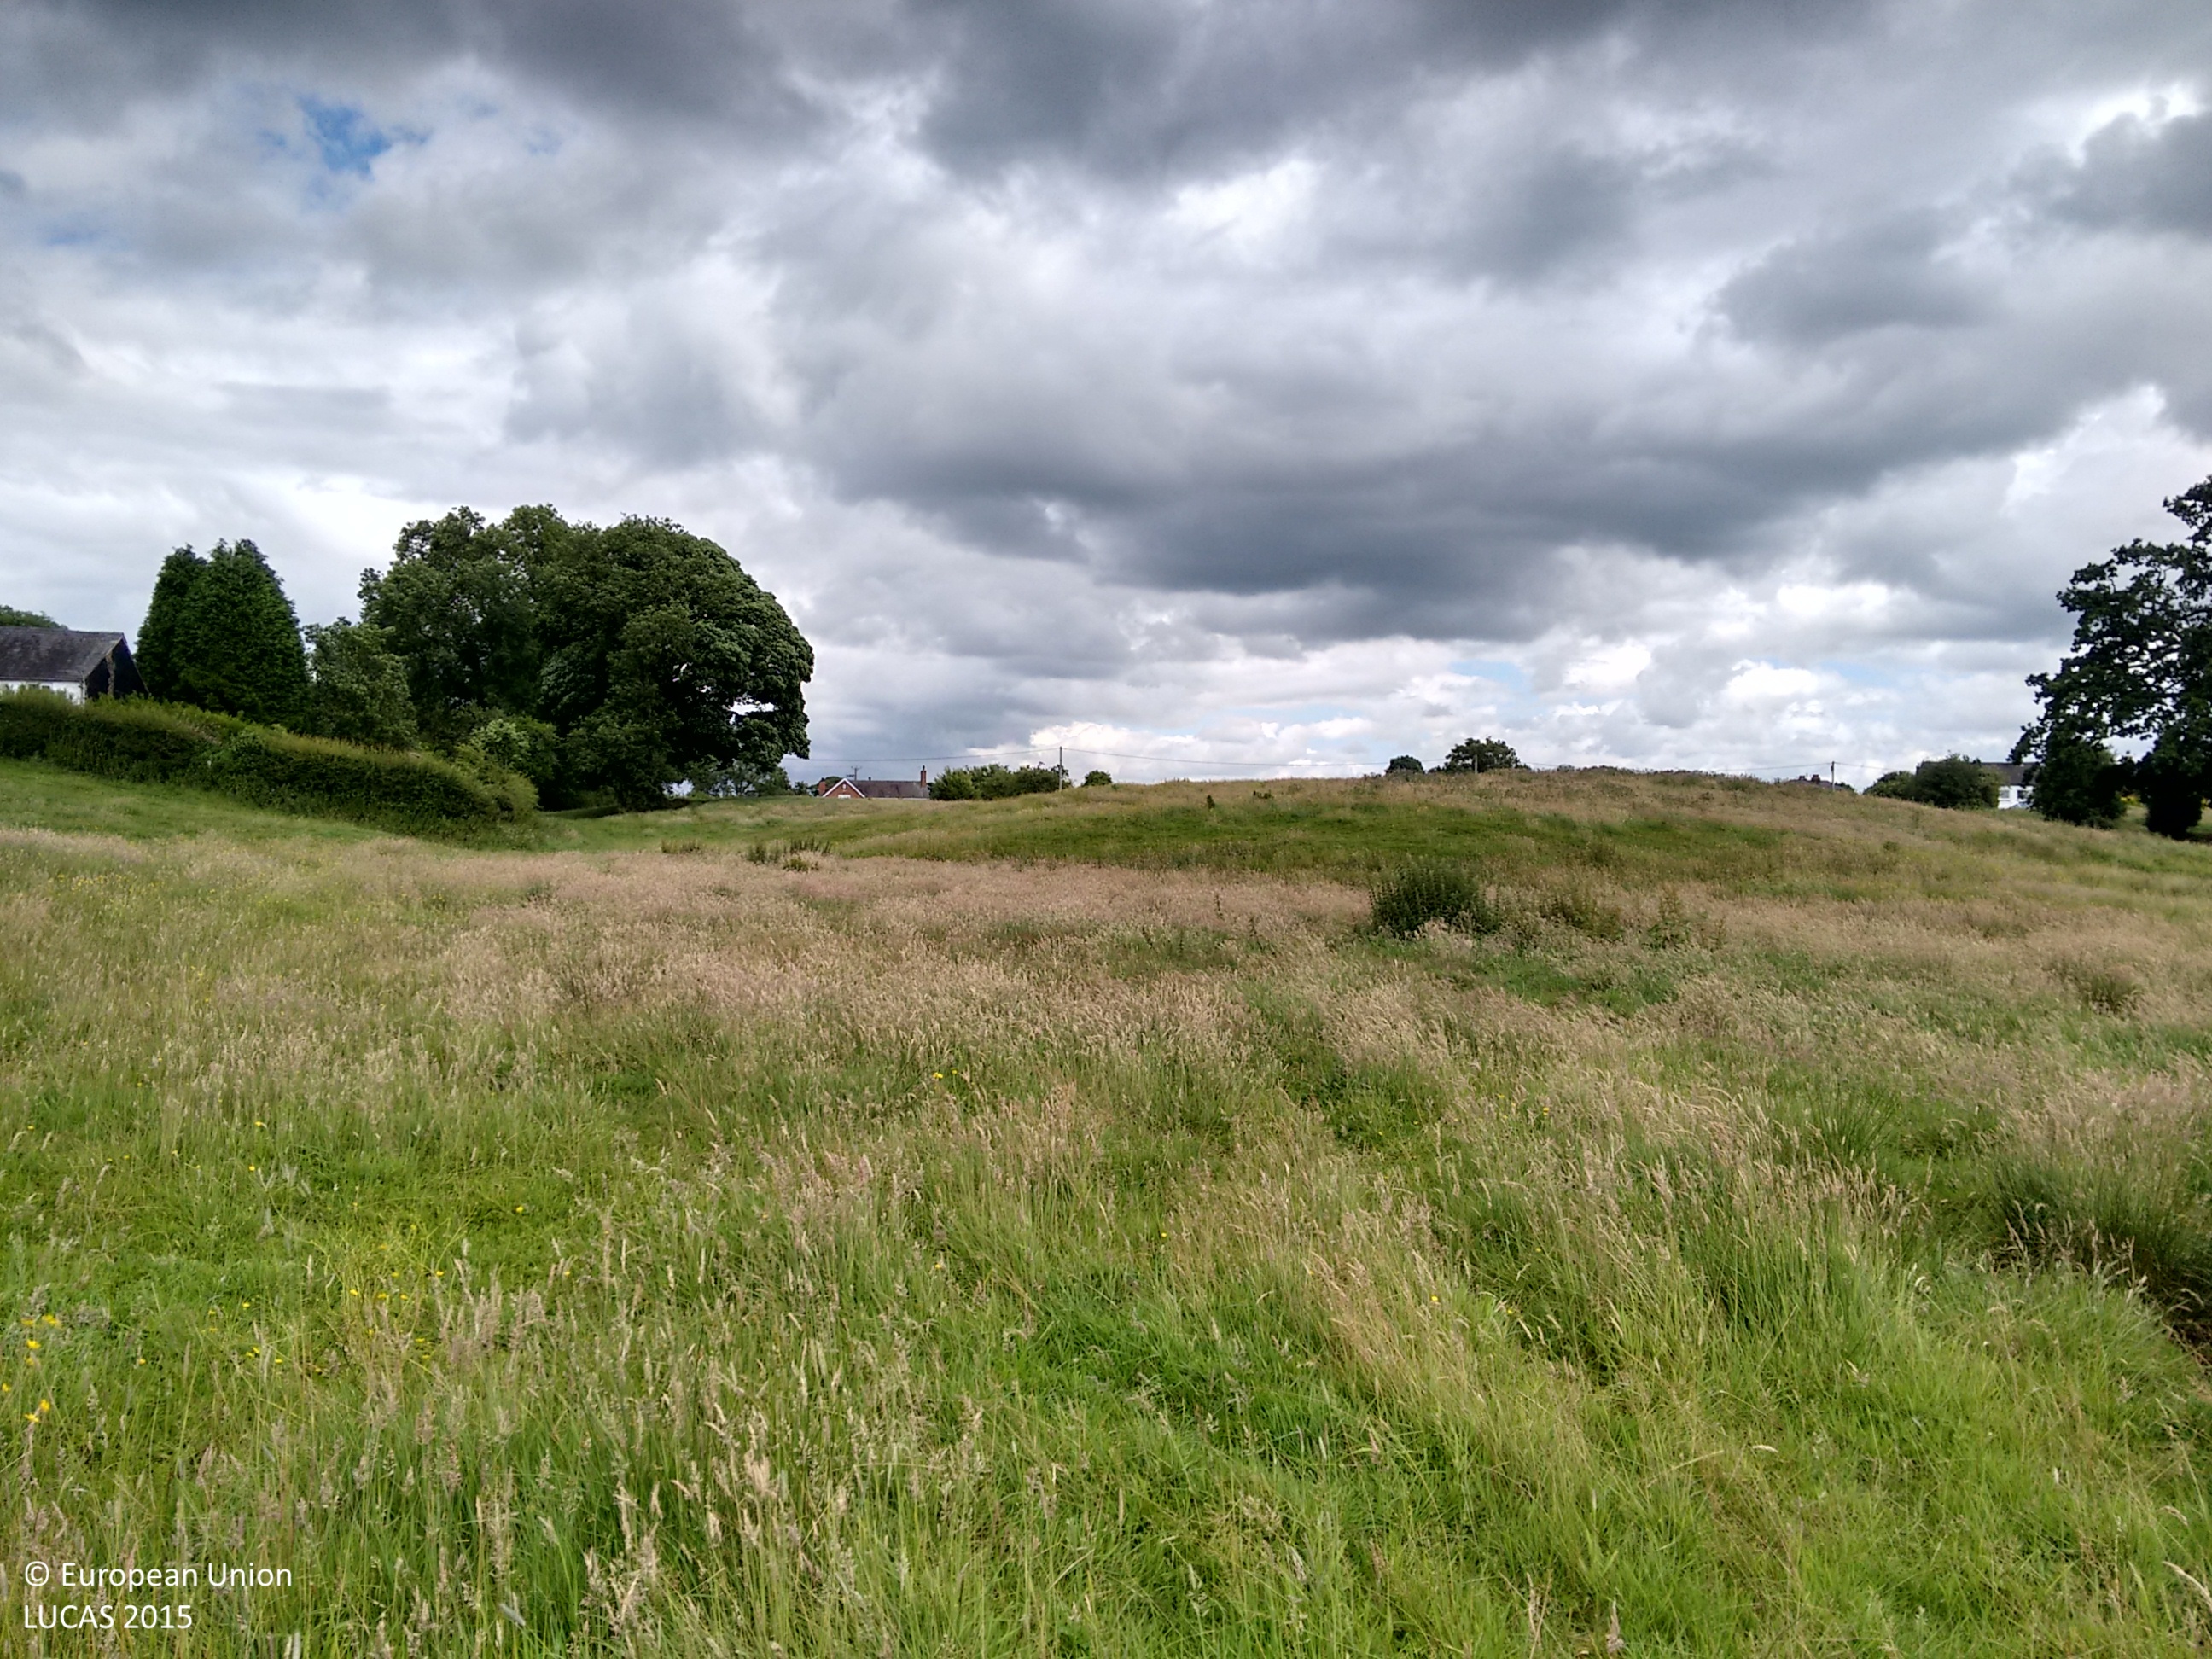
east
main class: Grassland
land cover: Grassland without tree/shrub cover
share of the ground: > 75 %
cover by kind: herbaceous plants 100 %
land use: Agriculture (excluding fallow land and kitchen gardens)
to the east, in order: Grassland without tree/shrub cover; Single bushes/trees; Grassland without tree/shrub cover; Managed hedges; Electric lines; Grass margins; Paved roads, cycling and walking lanes; Grass margins; Managed hedges; Grassland with sparse tree/shrub cover
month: July
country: GB
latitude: 53.3389
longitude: -2.2720
